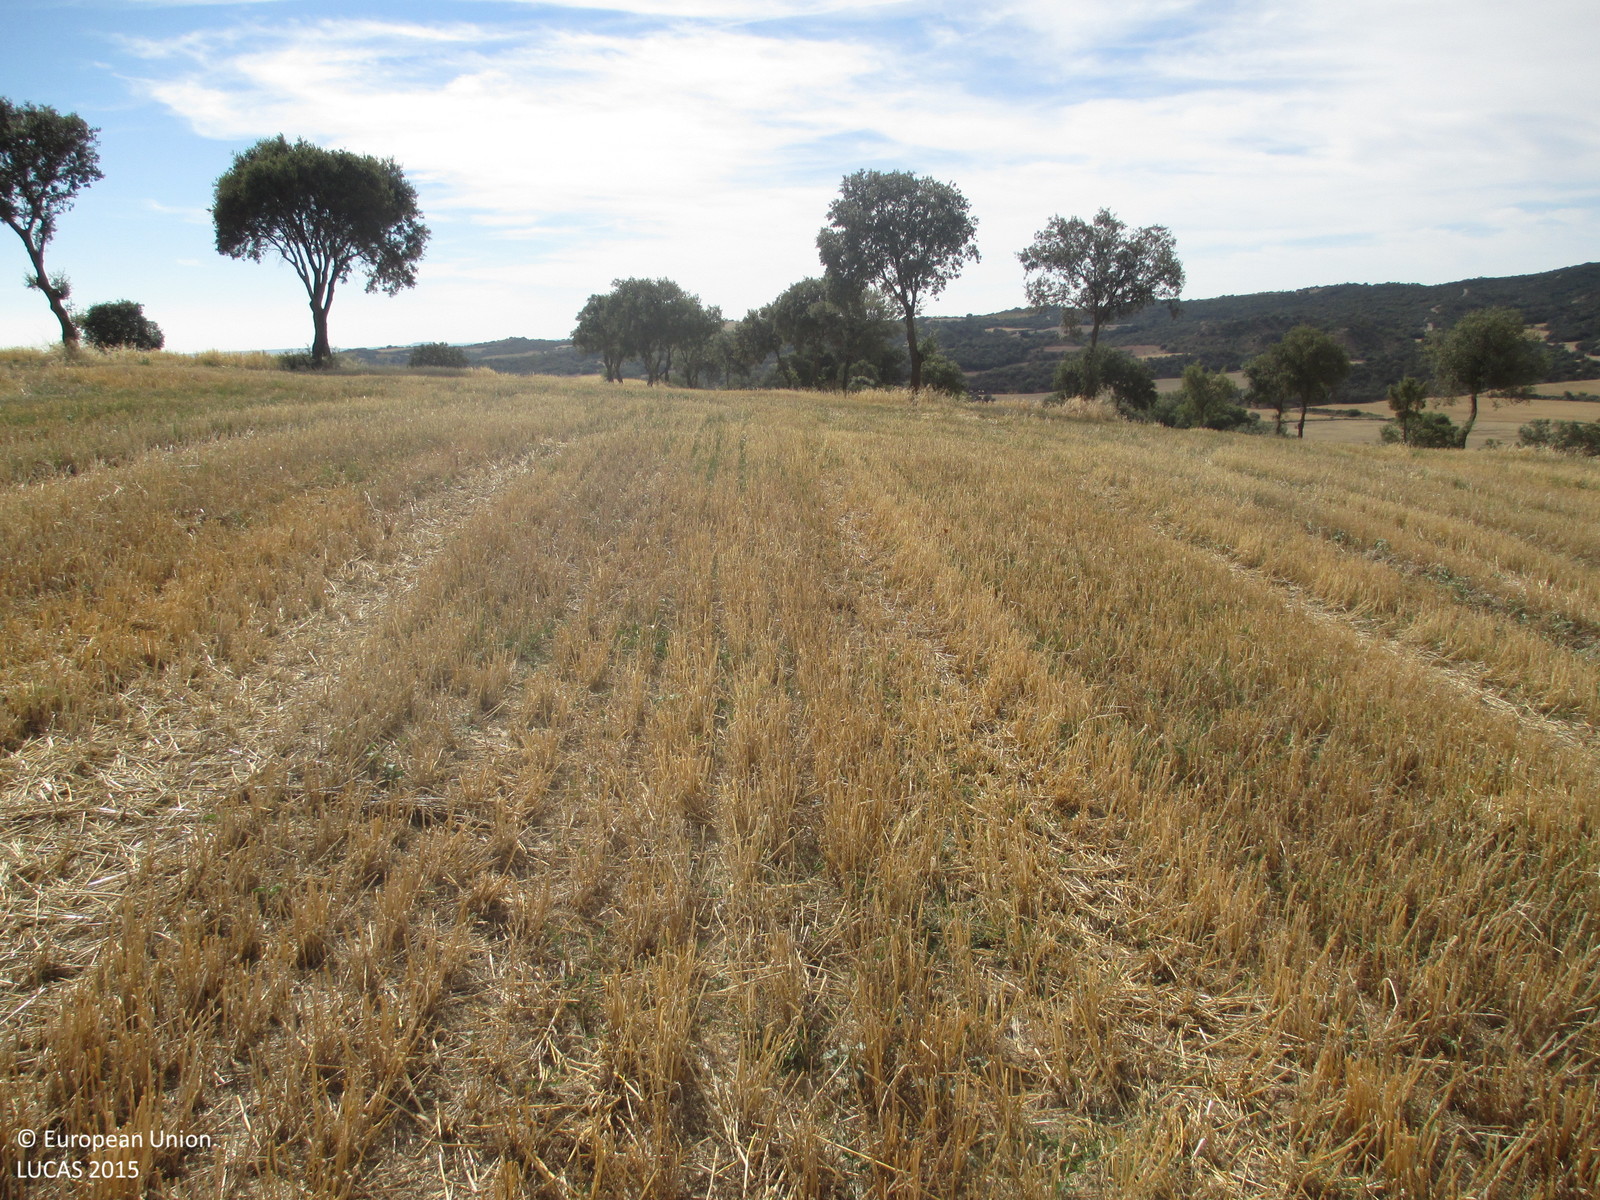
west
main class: Cropland
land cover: Barley
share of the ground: < 10 %
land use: Agriculture (excluding fallow land and kitchen gardens)
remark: Harvested field
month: July
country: ES
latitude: 41.9577
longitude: 0.3681
